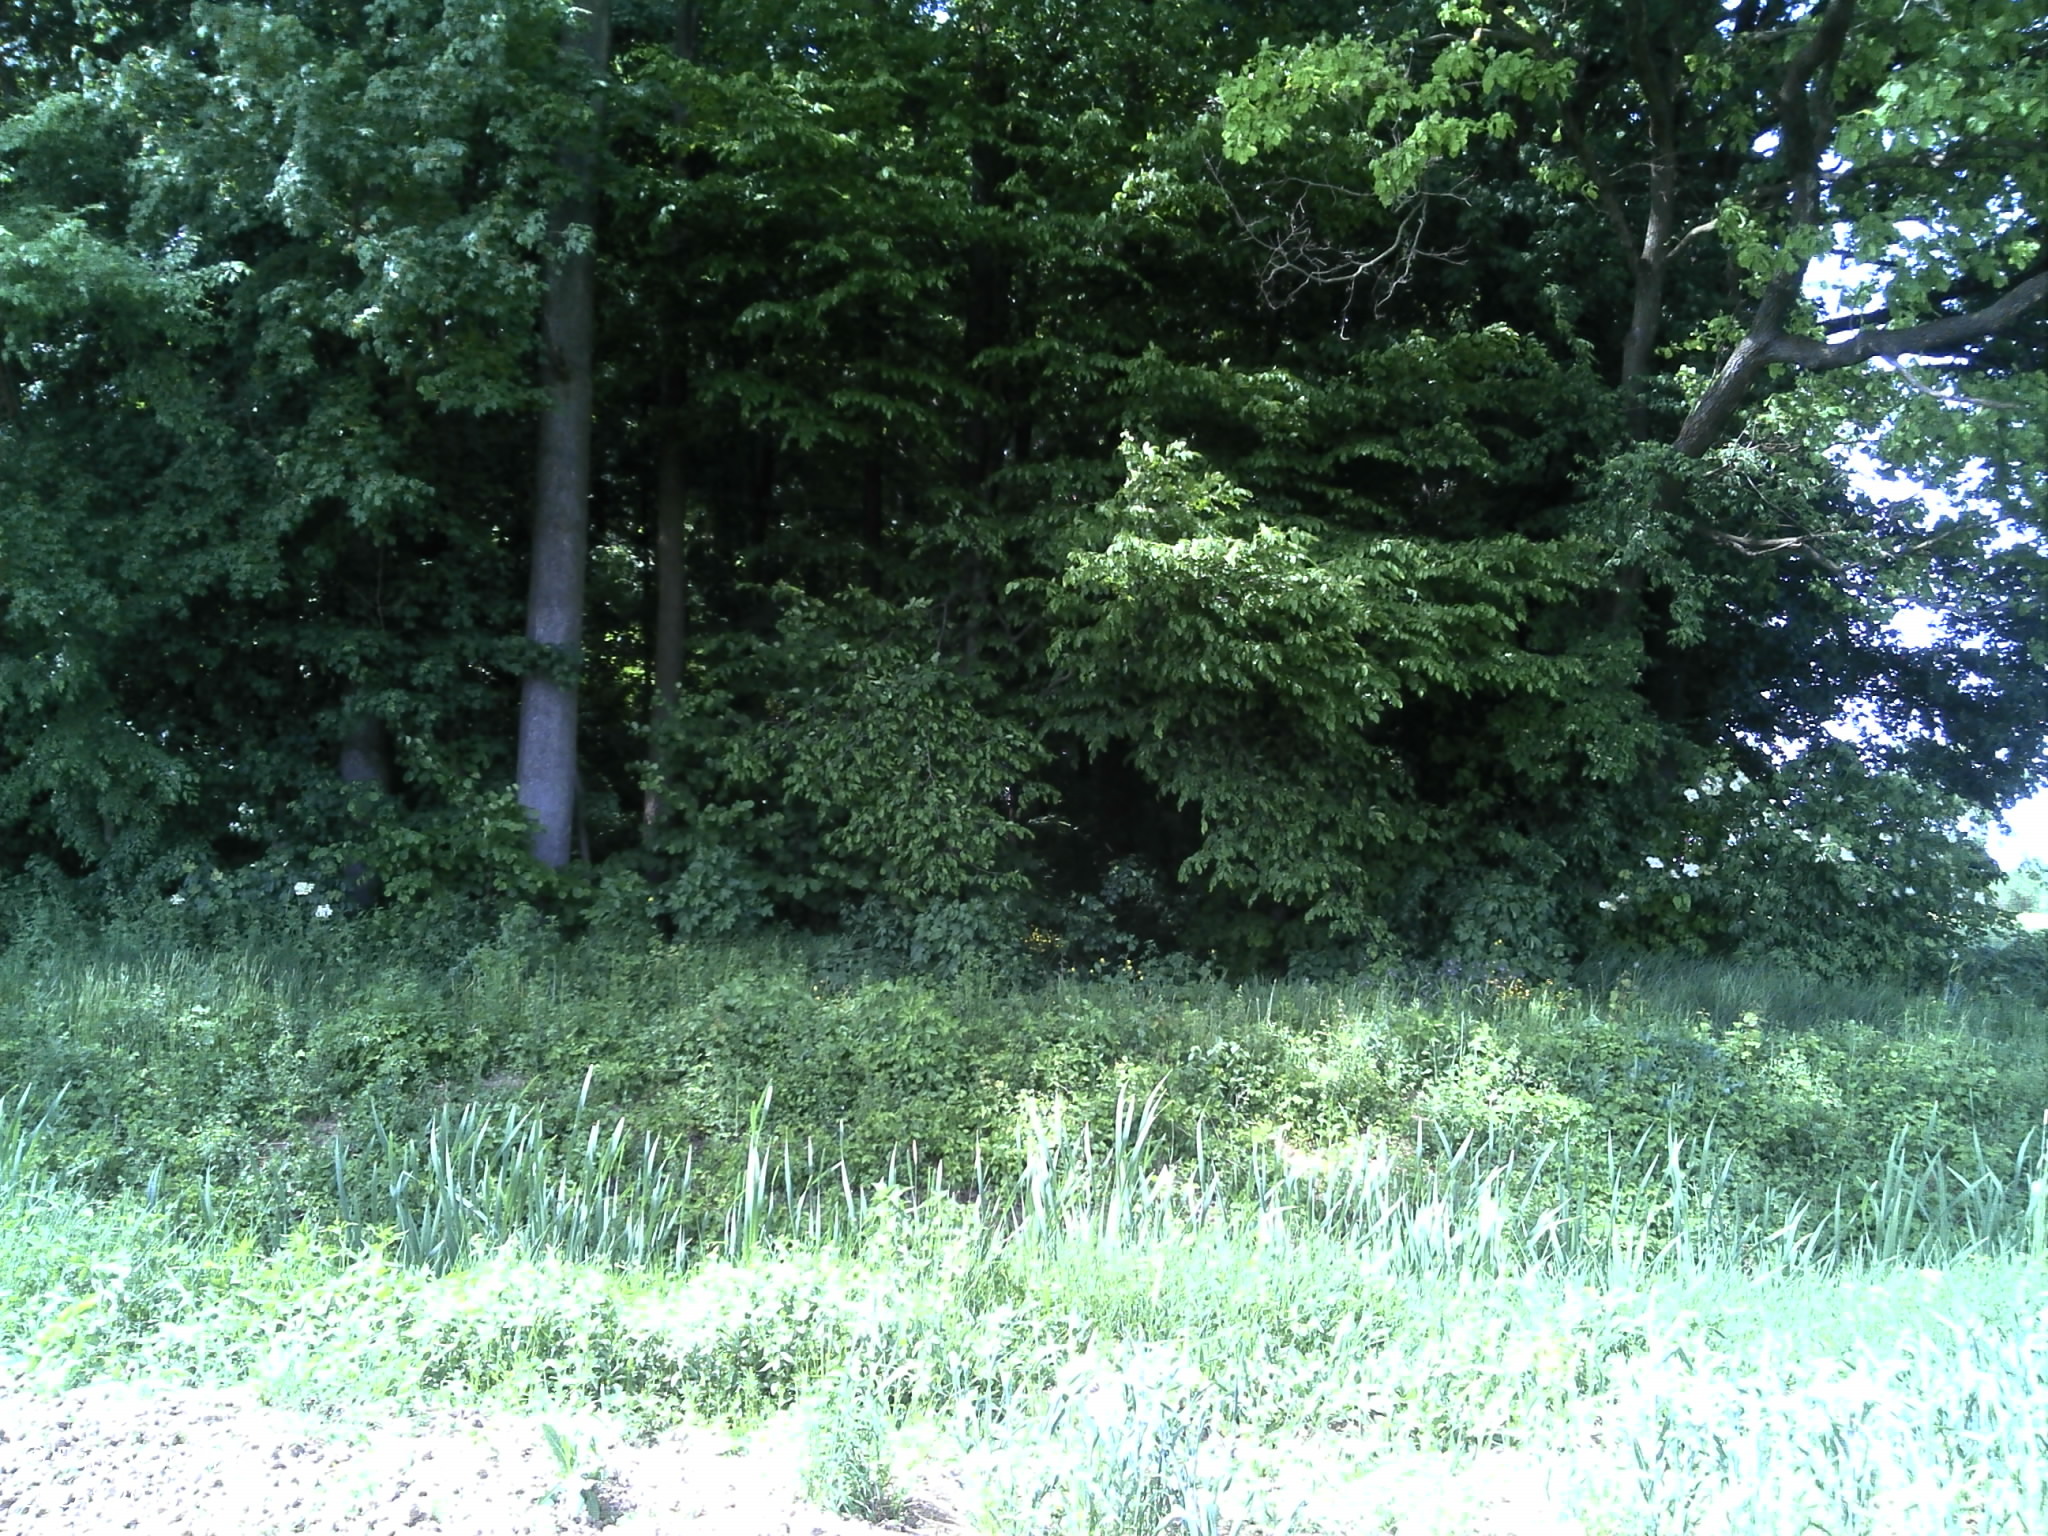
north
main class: Cropland
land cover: Common wheat
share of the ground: > 75 %
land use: Agriculture (excluding fallow land and kitchen gardens)
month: May
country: HR
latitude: 45.1640
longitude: 18.4650
